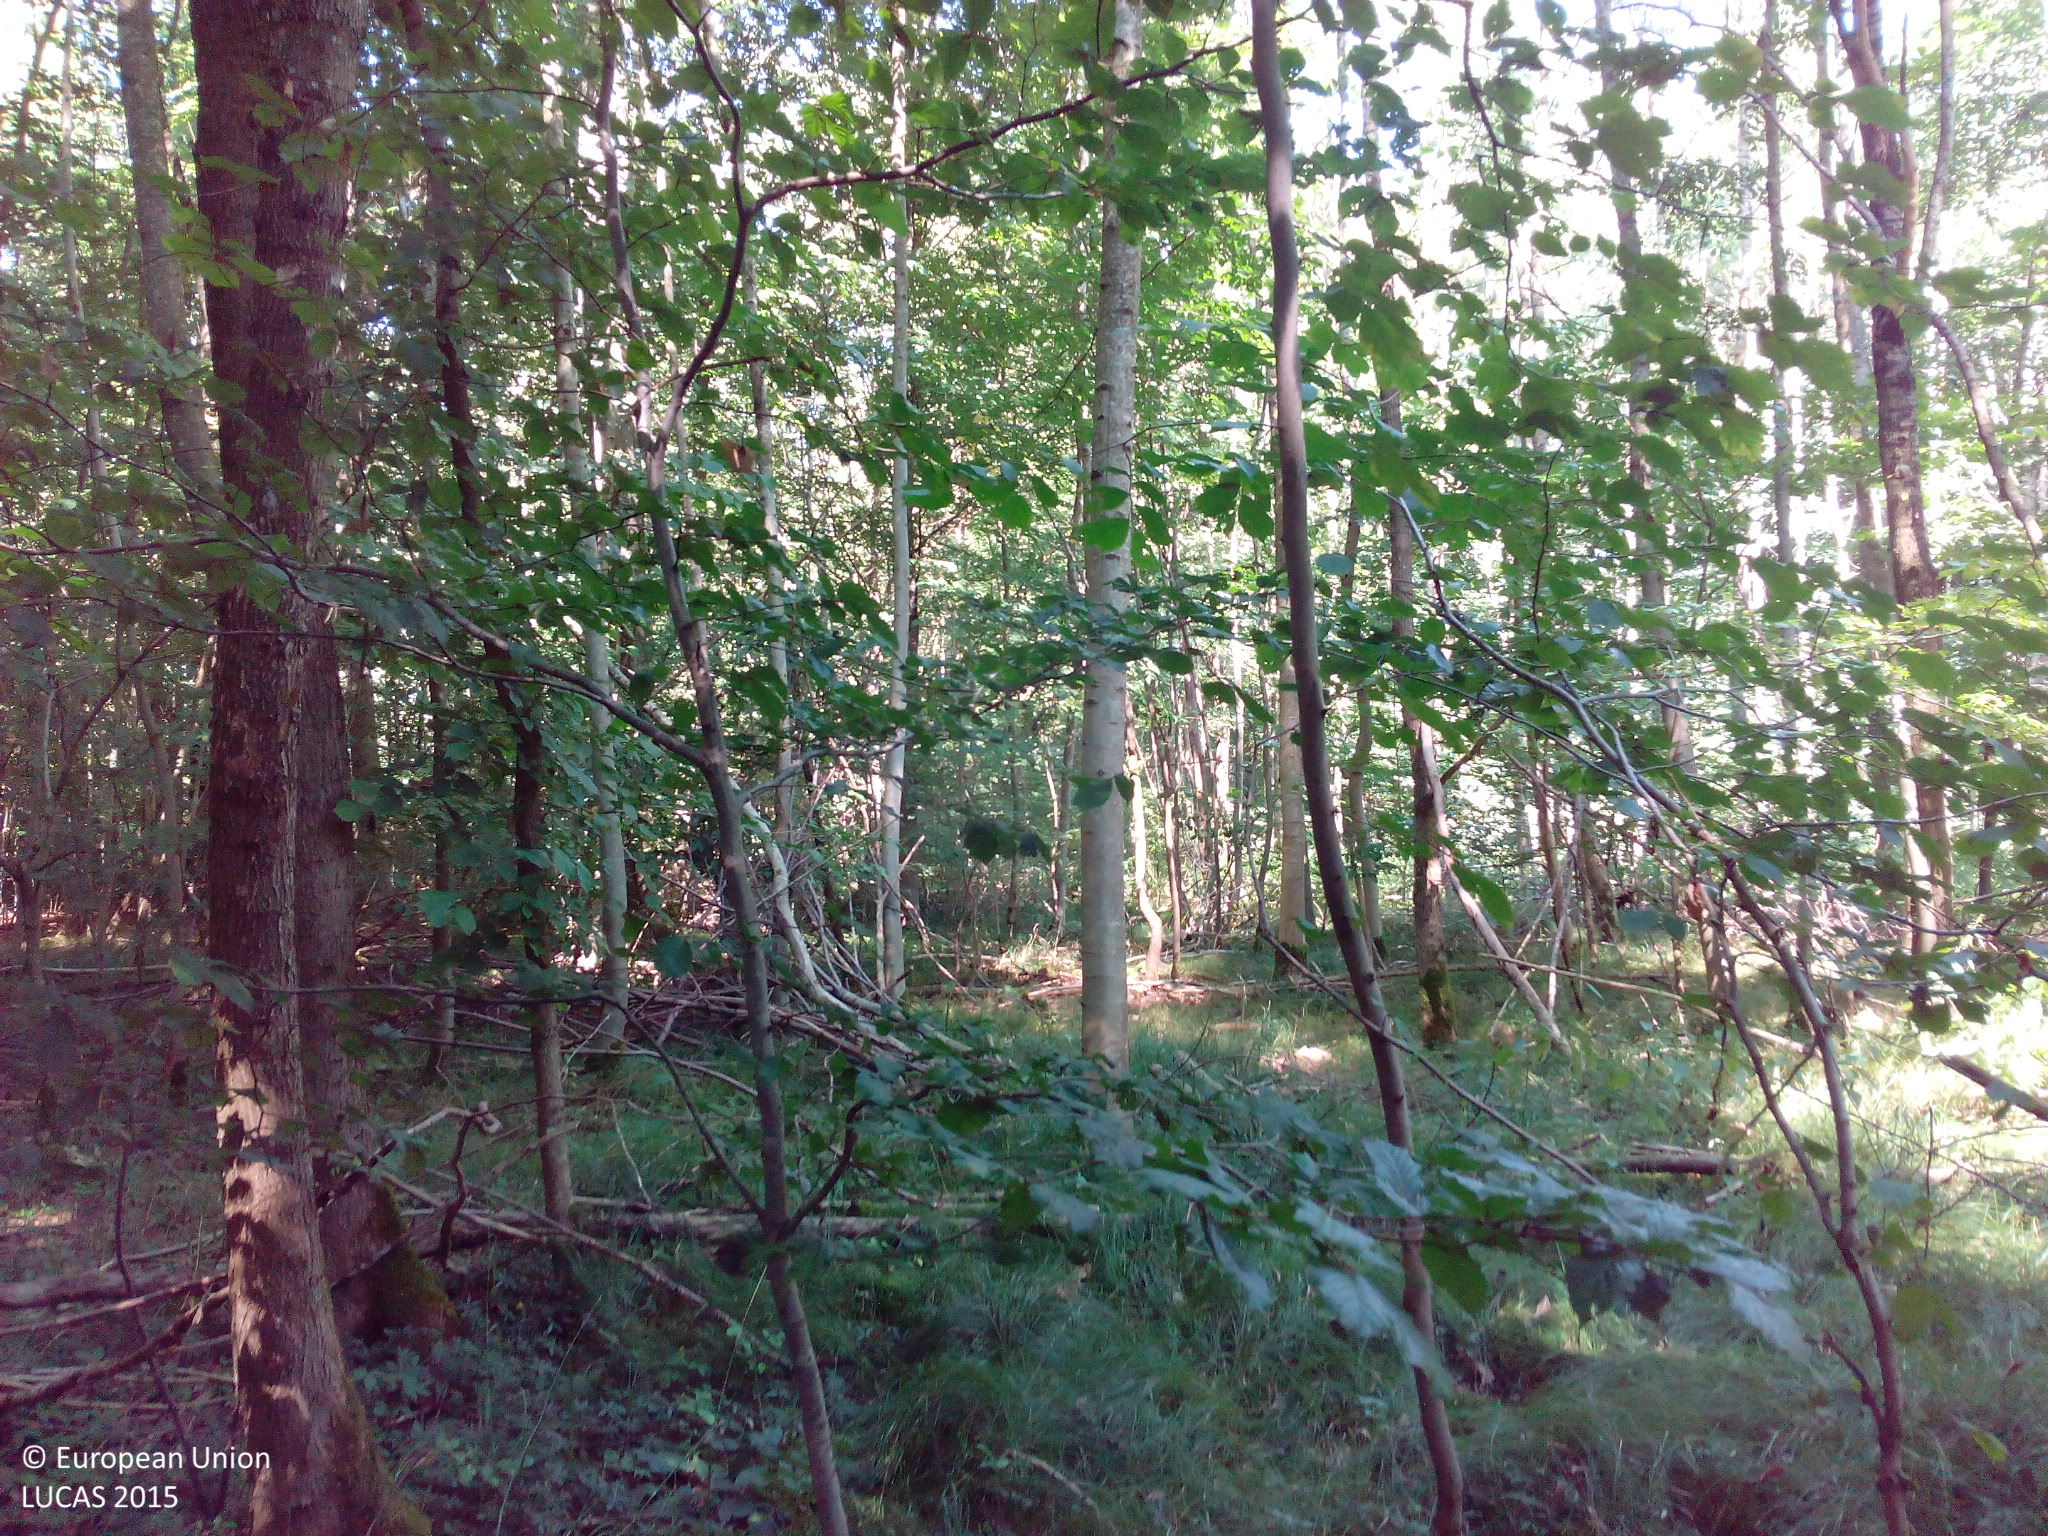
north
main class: Woodland
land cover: Broadleaved woodland
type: mesophytic deciduous forest
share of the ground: > 75 %
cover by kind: broadleaved forest trees 90 %, shrubs 5 %, unconsolidated bare surface 5 %
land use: Forestry
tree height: > 5 m
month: August
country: DE
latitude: 48.6551
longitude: 10.2578
